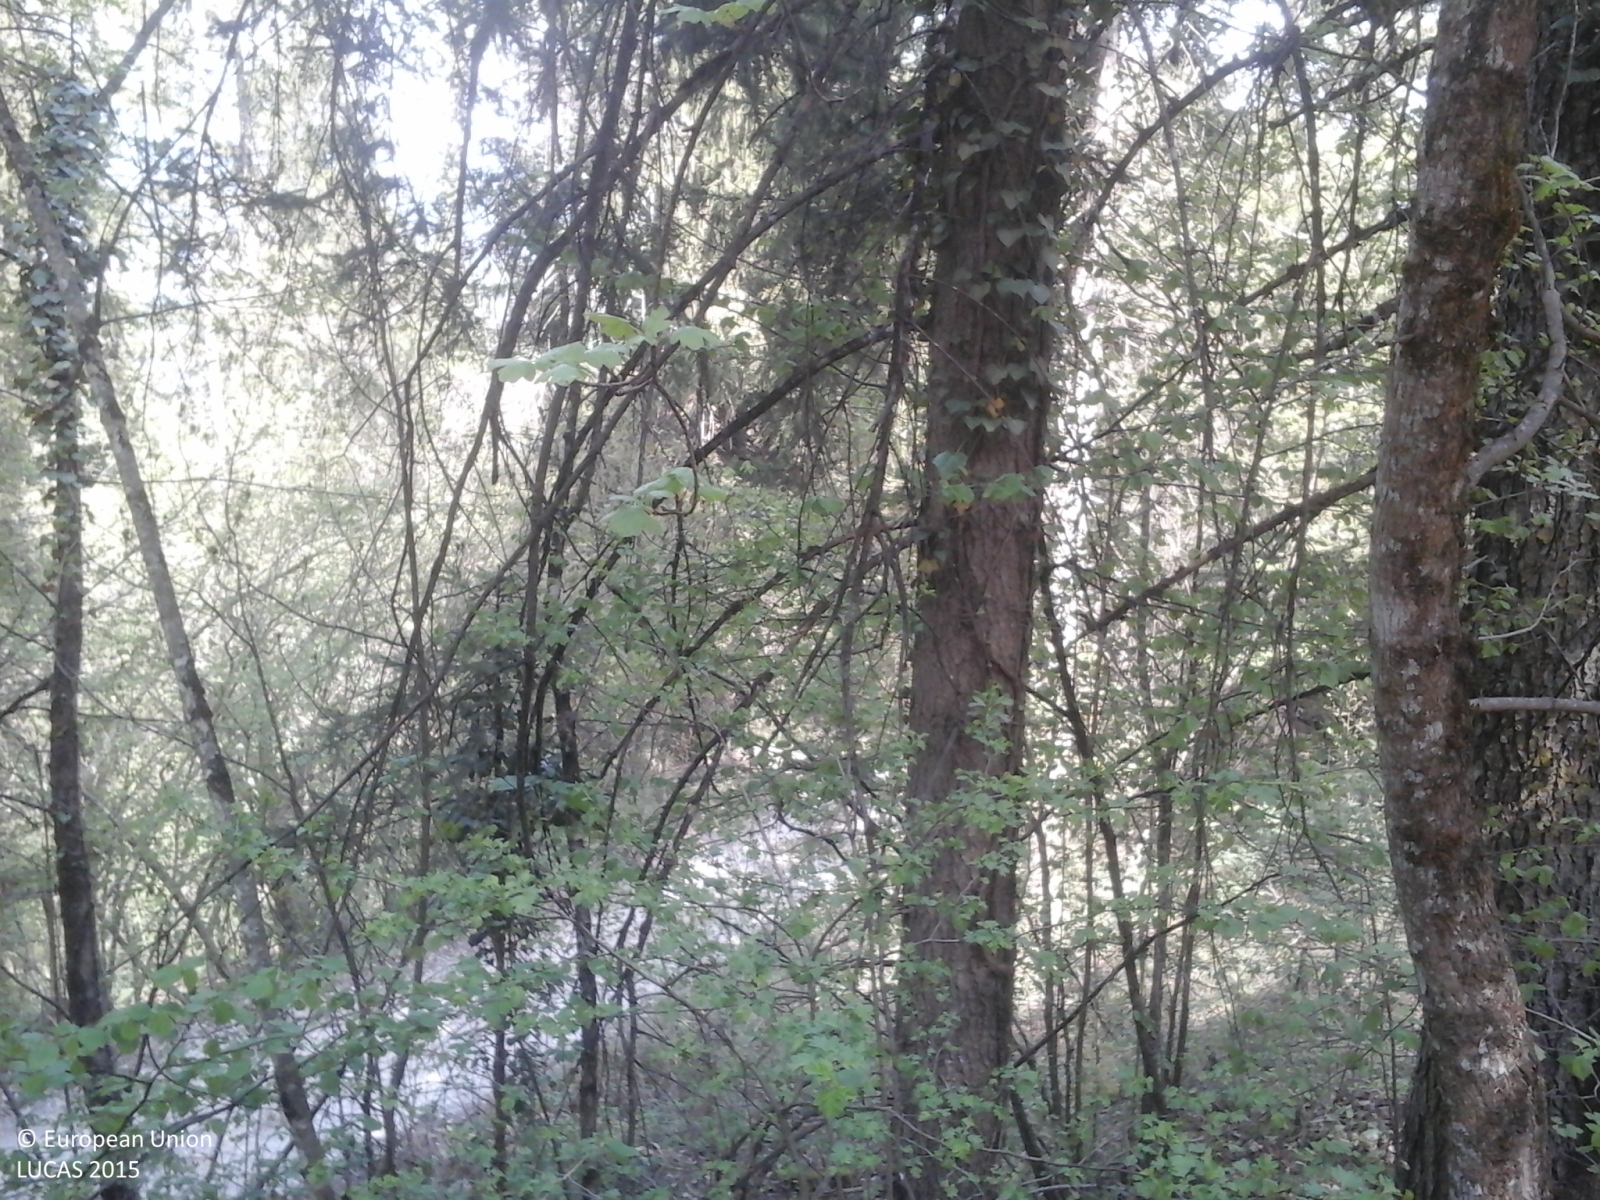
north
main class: Woodland
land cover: Other mixed woodland
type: mesophytic deciduous forest
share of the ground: > 75 %
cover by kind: coniferous forest trees 50 %, broadleaved forest trees 50 %
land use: Forestry
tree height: > 5 m
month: April
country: IT
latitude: 46.3635
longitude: 11.1034
